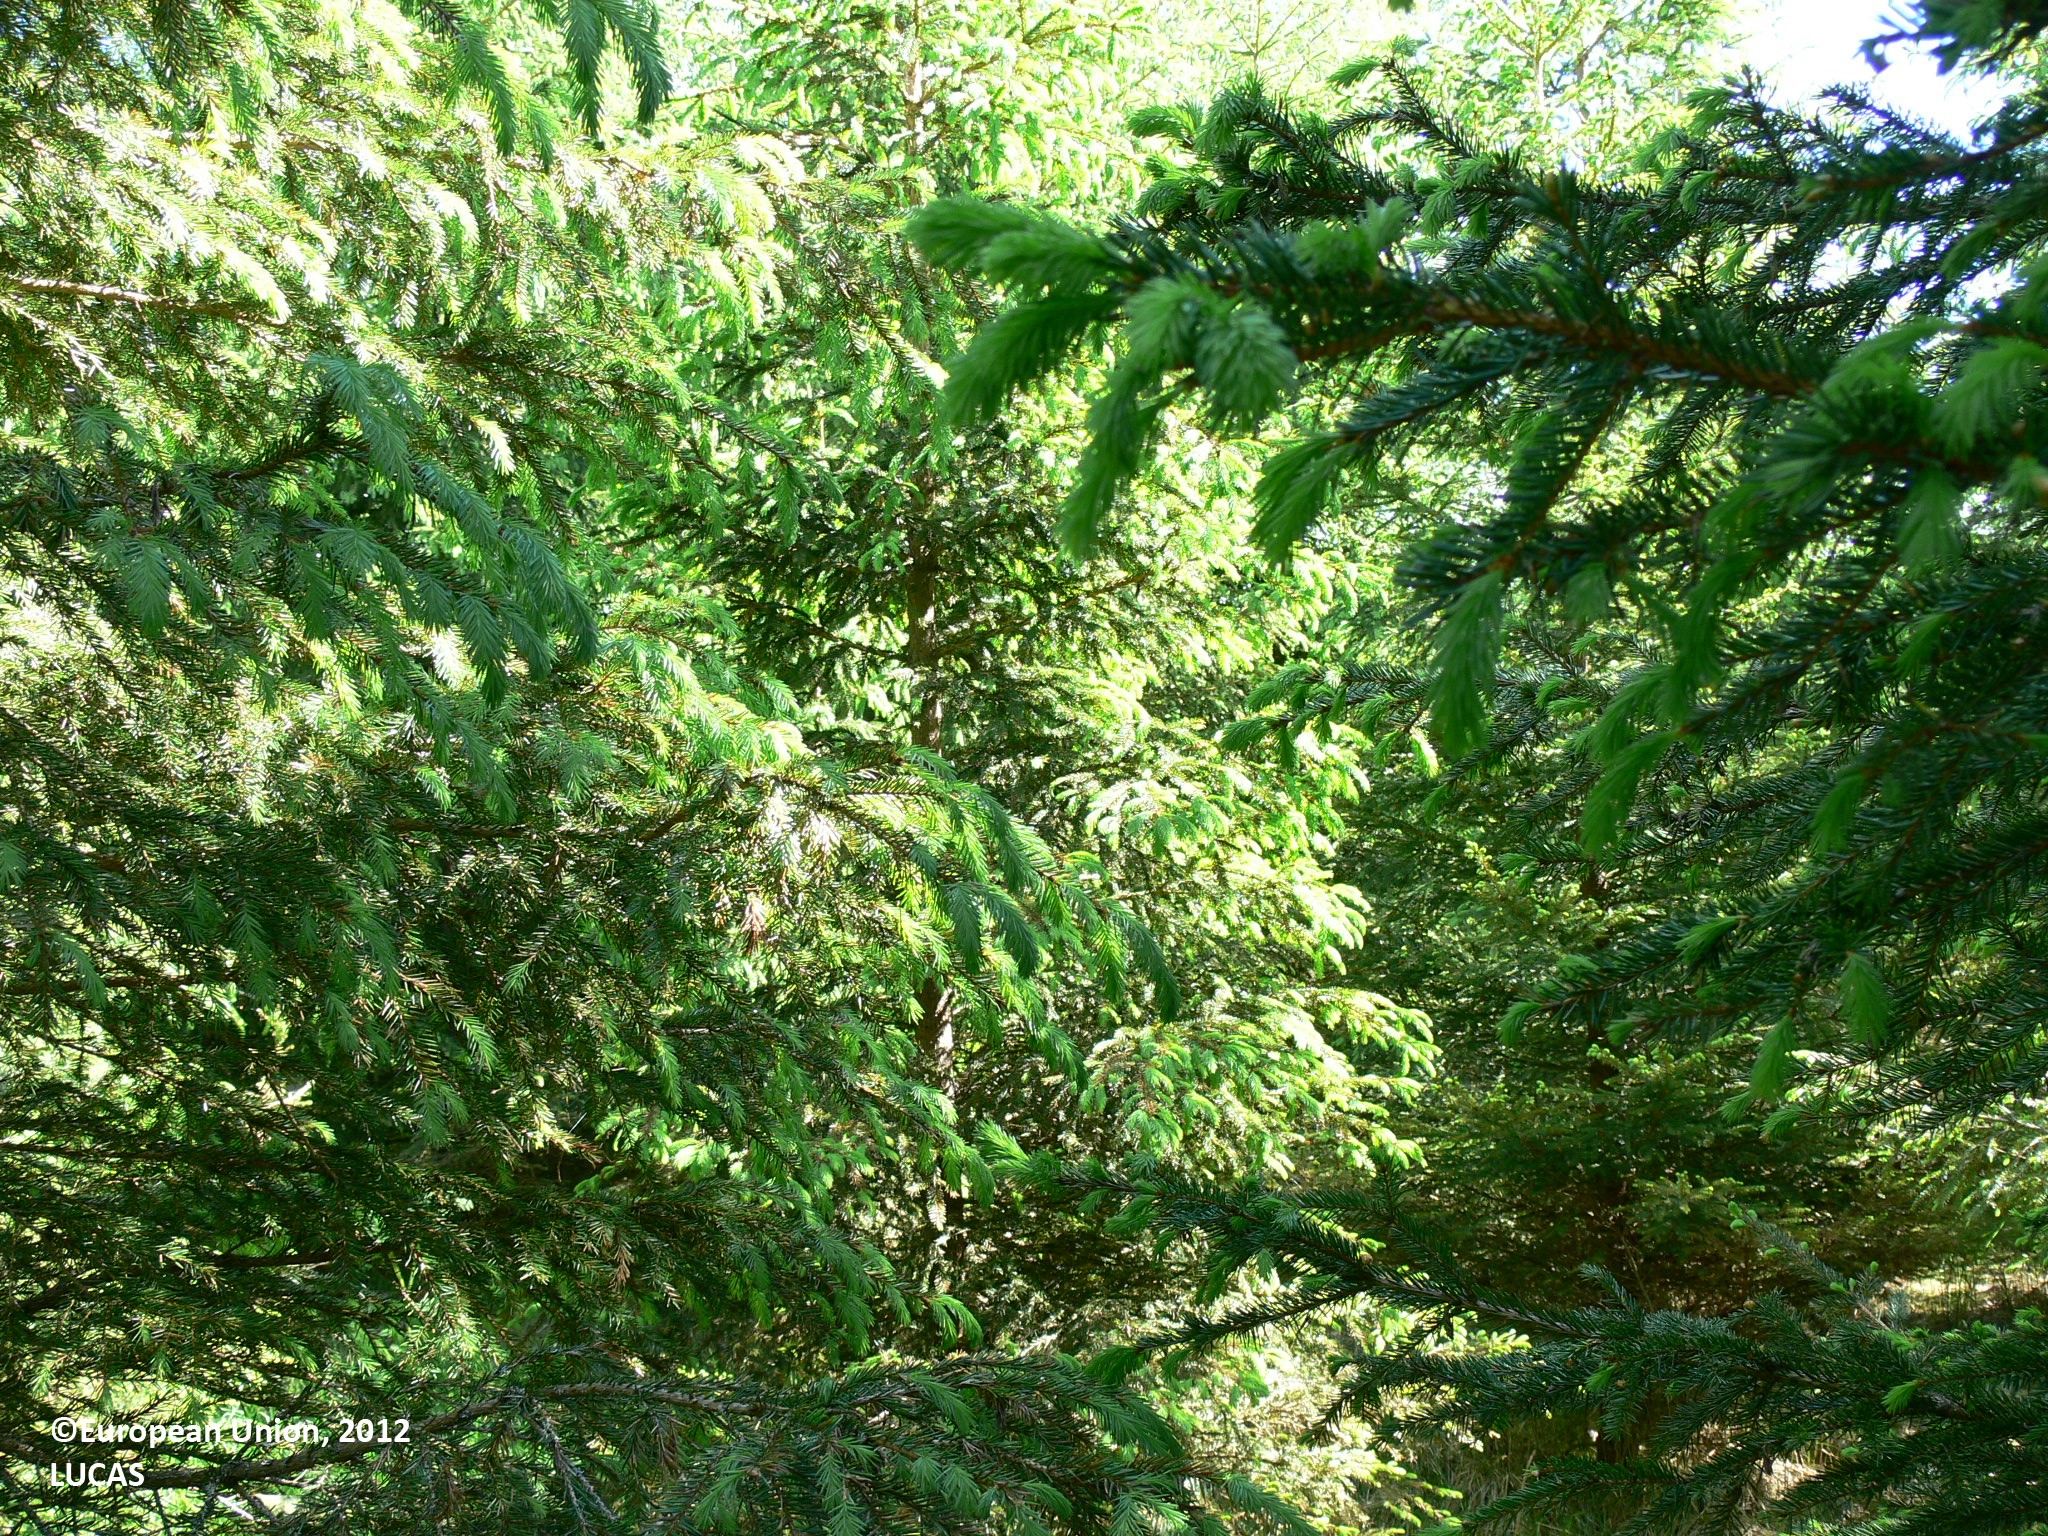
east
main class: Woodland
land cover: Spruce dominated coniferous woodland
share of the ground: > 75 %
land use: Forestry
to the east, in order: Spruce dominated coniferous woodland; Ditches and canals; Other mixed woodland; Ditches and canals; Spruce dominated coniferous woodland; Broadleaved woodland; Other mixed woodland; Spruce dominated coniferous woodland
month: June
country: FI
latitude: 62.3432
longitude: 30.4631
